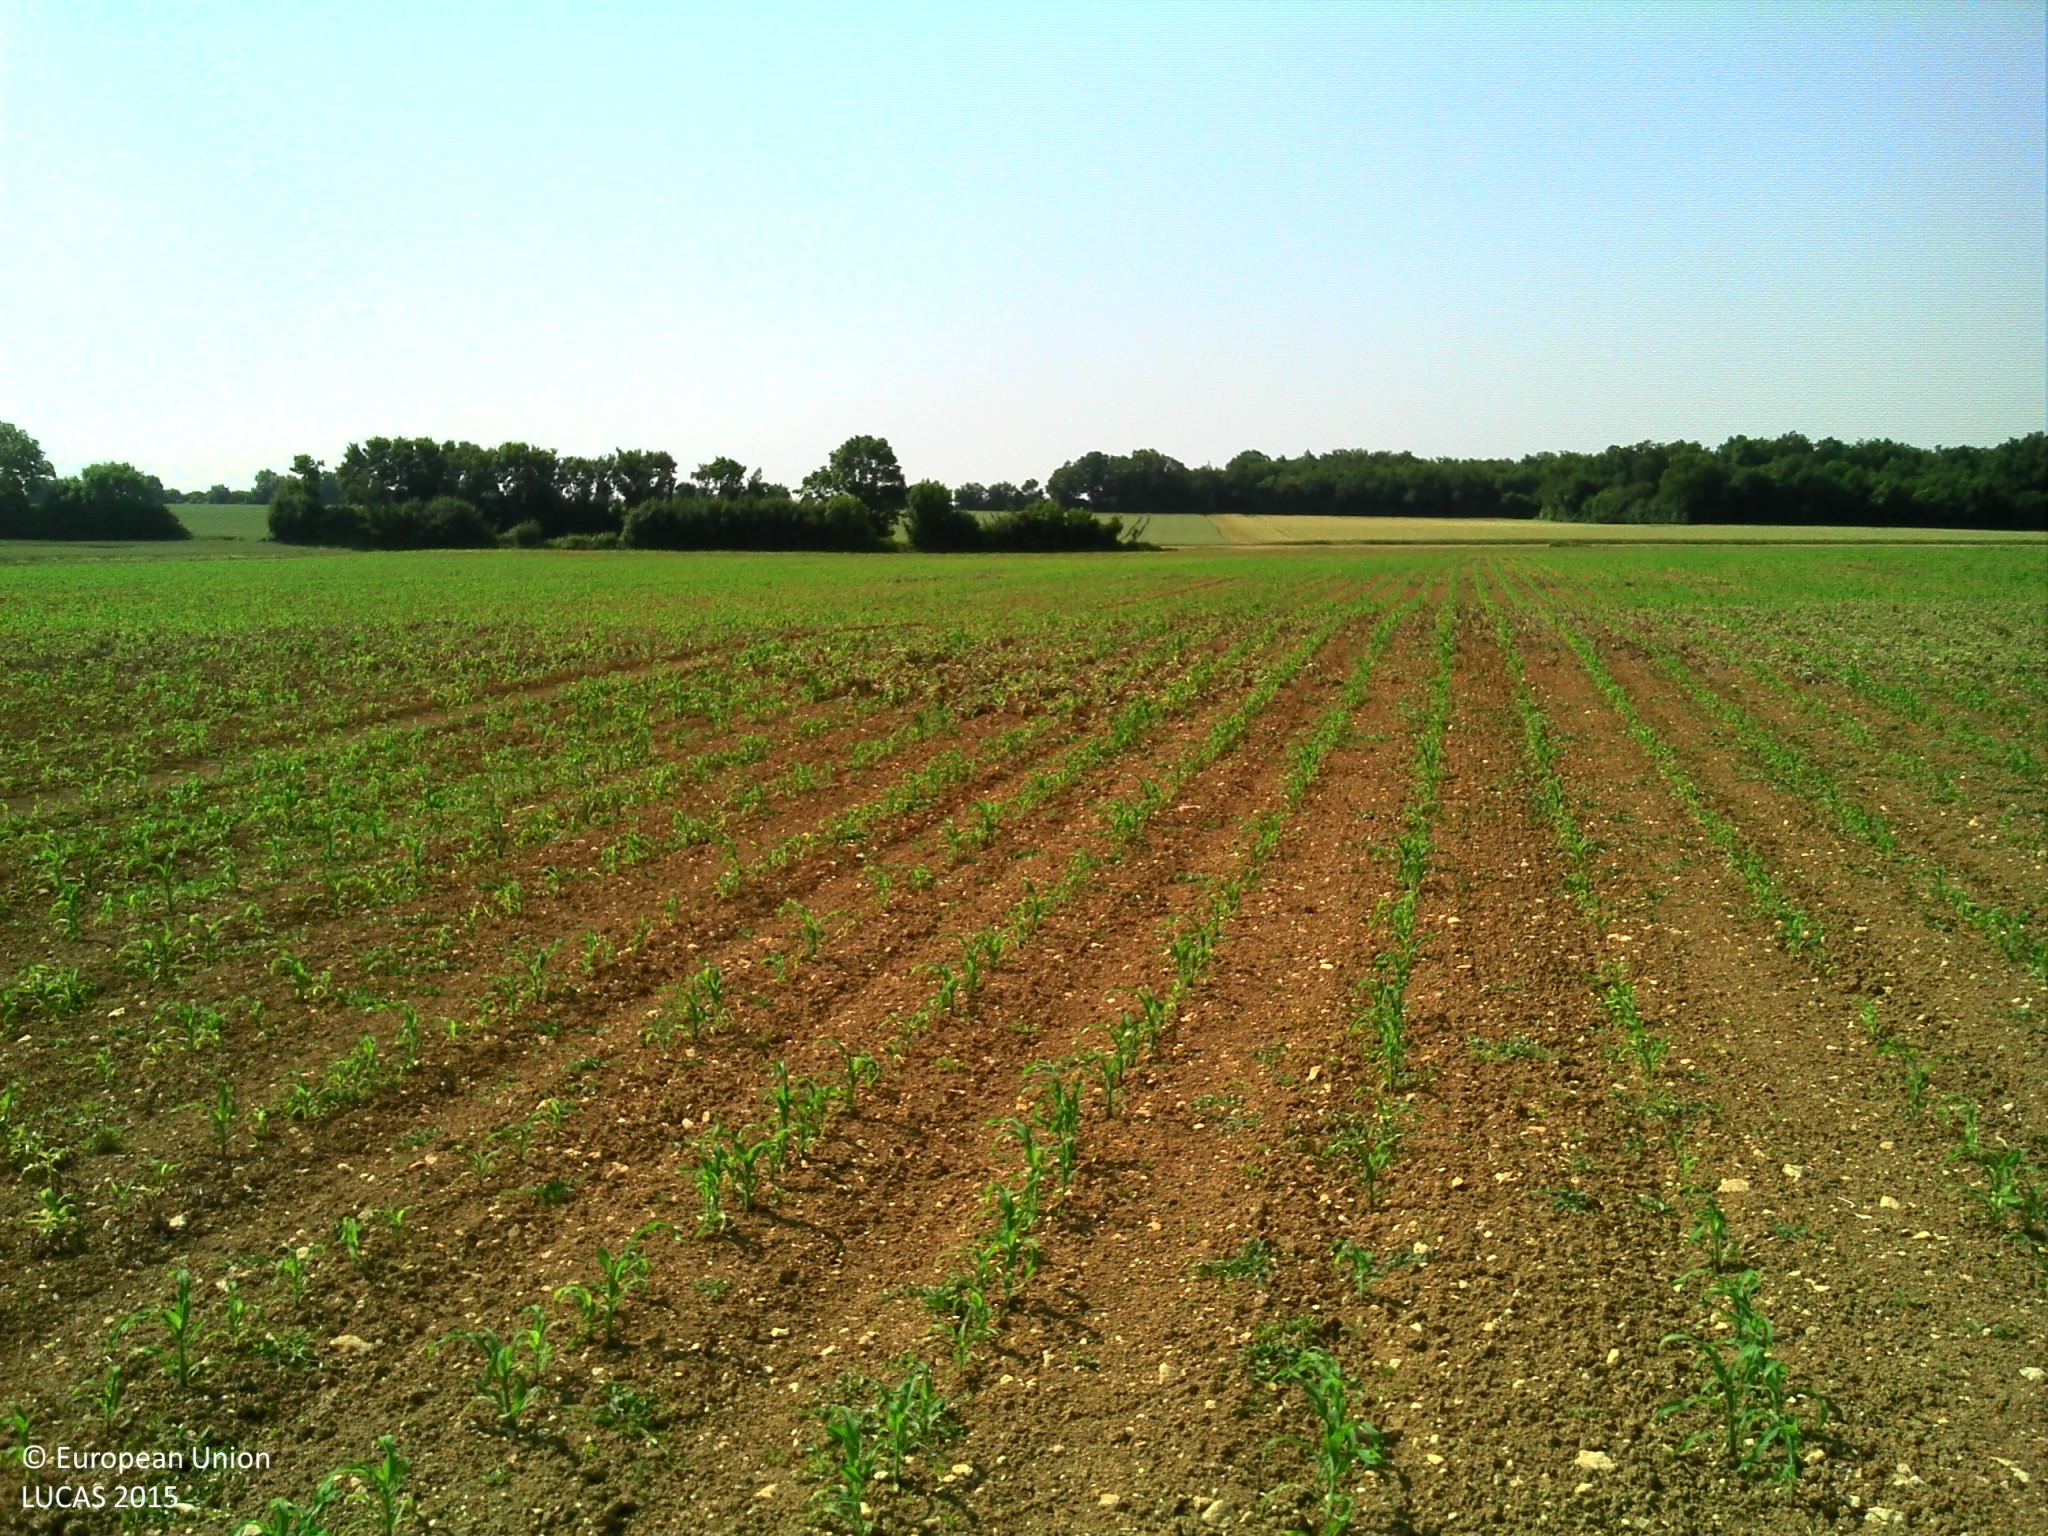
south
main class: Cropland
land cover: Maize
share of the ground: < 10 %
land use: Agriculture (excluding fallow land and kitchen gardens)
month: June
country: FR
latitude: 46.0800
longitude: -0.9299
